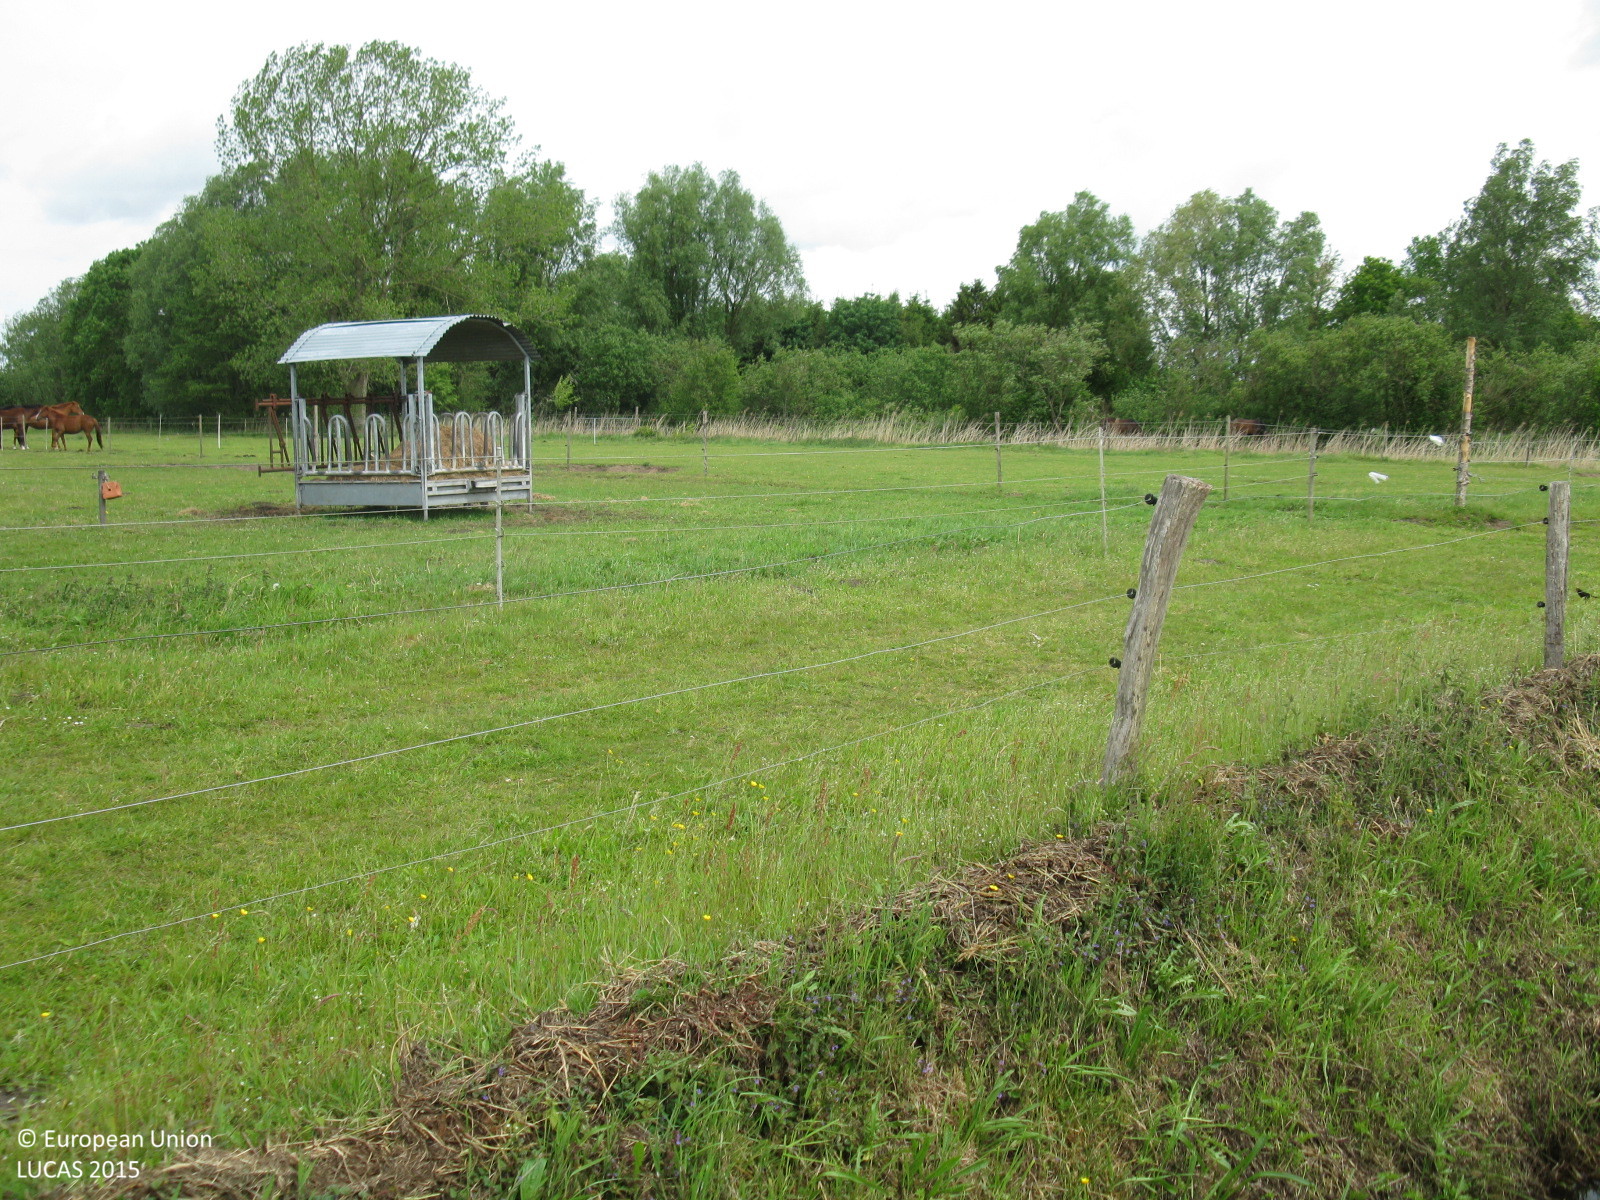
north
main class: Grassland
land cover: Grassland without tree/shrub cover
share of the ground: > 75 %
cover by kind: herbaceous plants 100 %
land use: Agriculture (excluding fallow land and kitchen gardens)
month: June
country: DE
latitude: 53.1739
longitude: 7.2926
